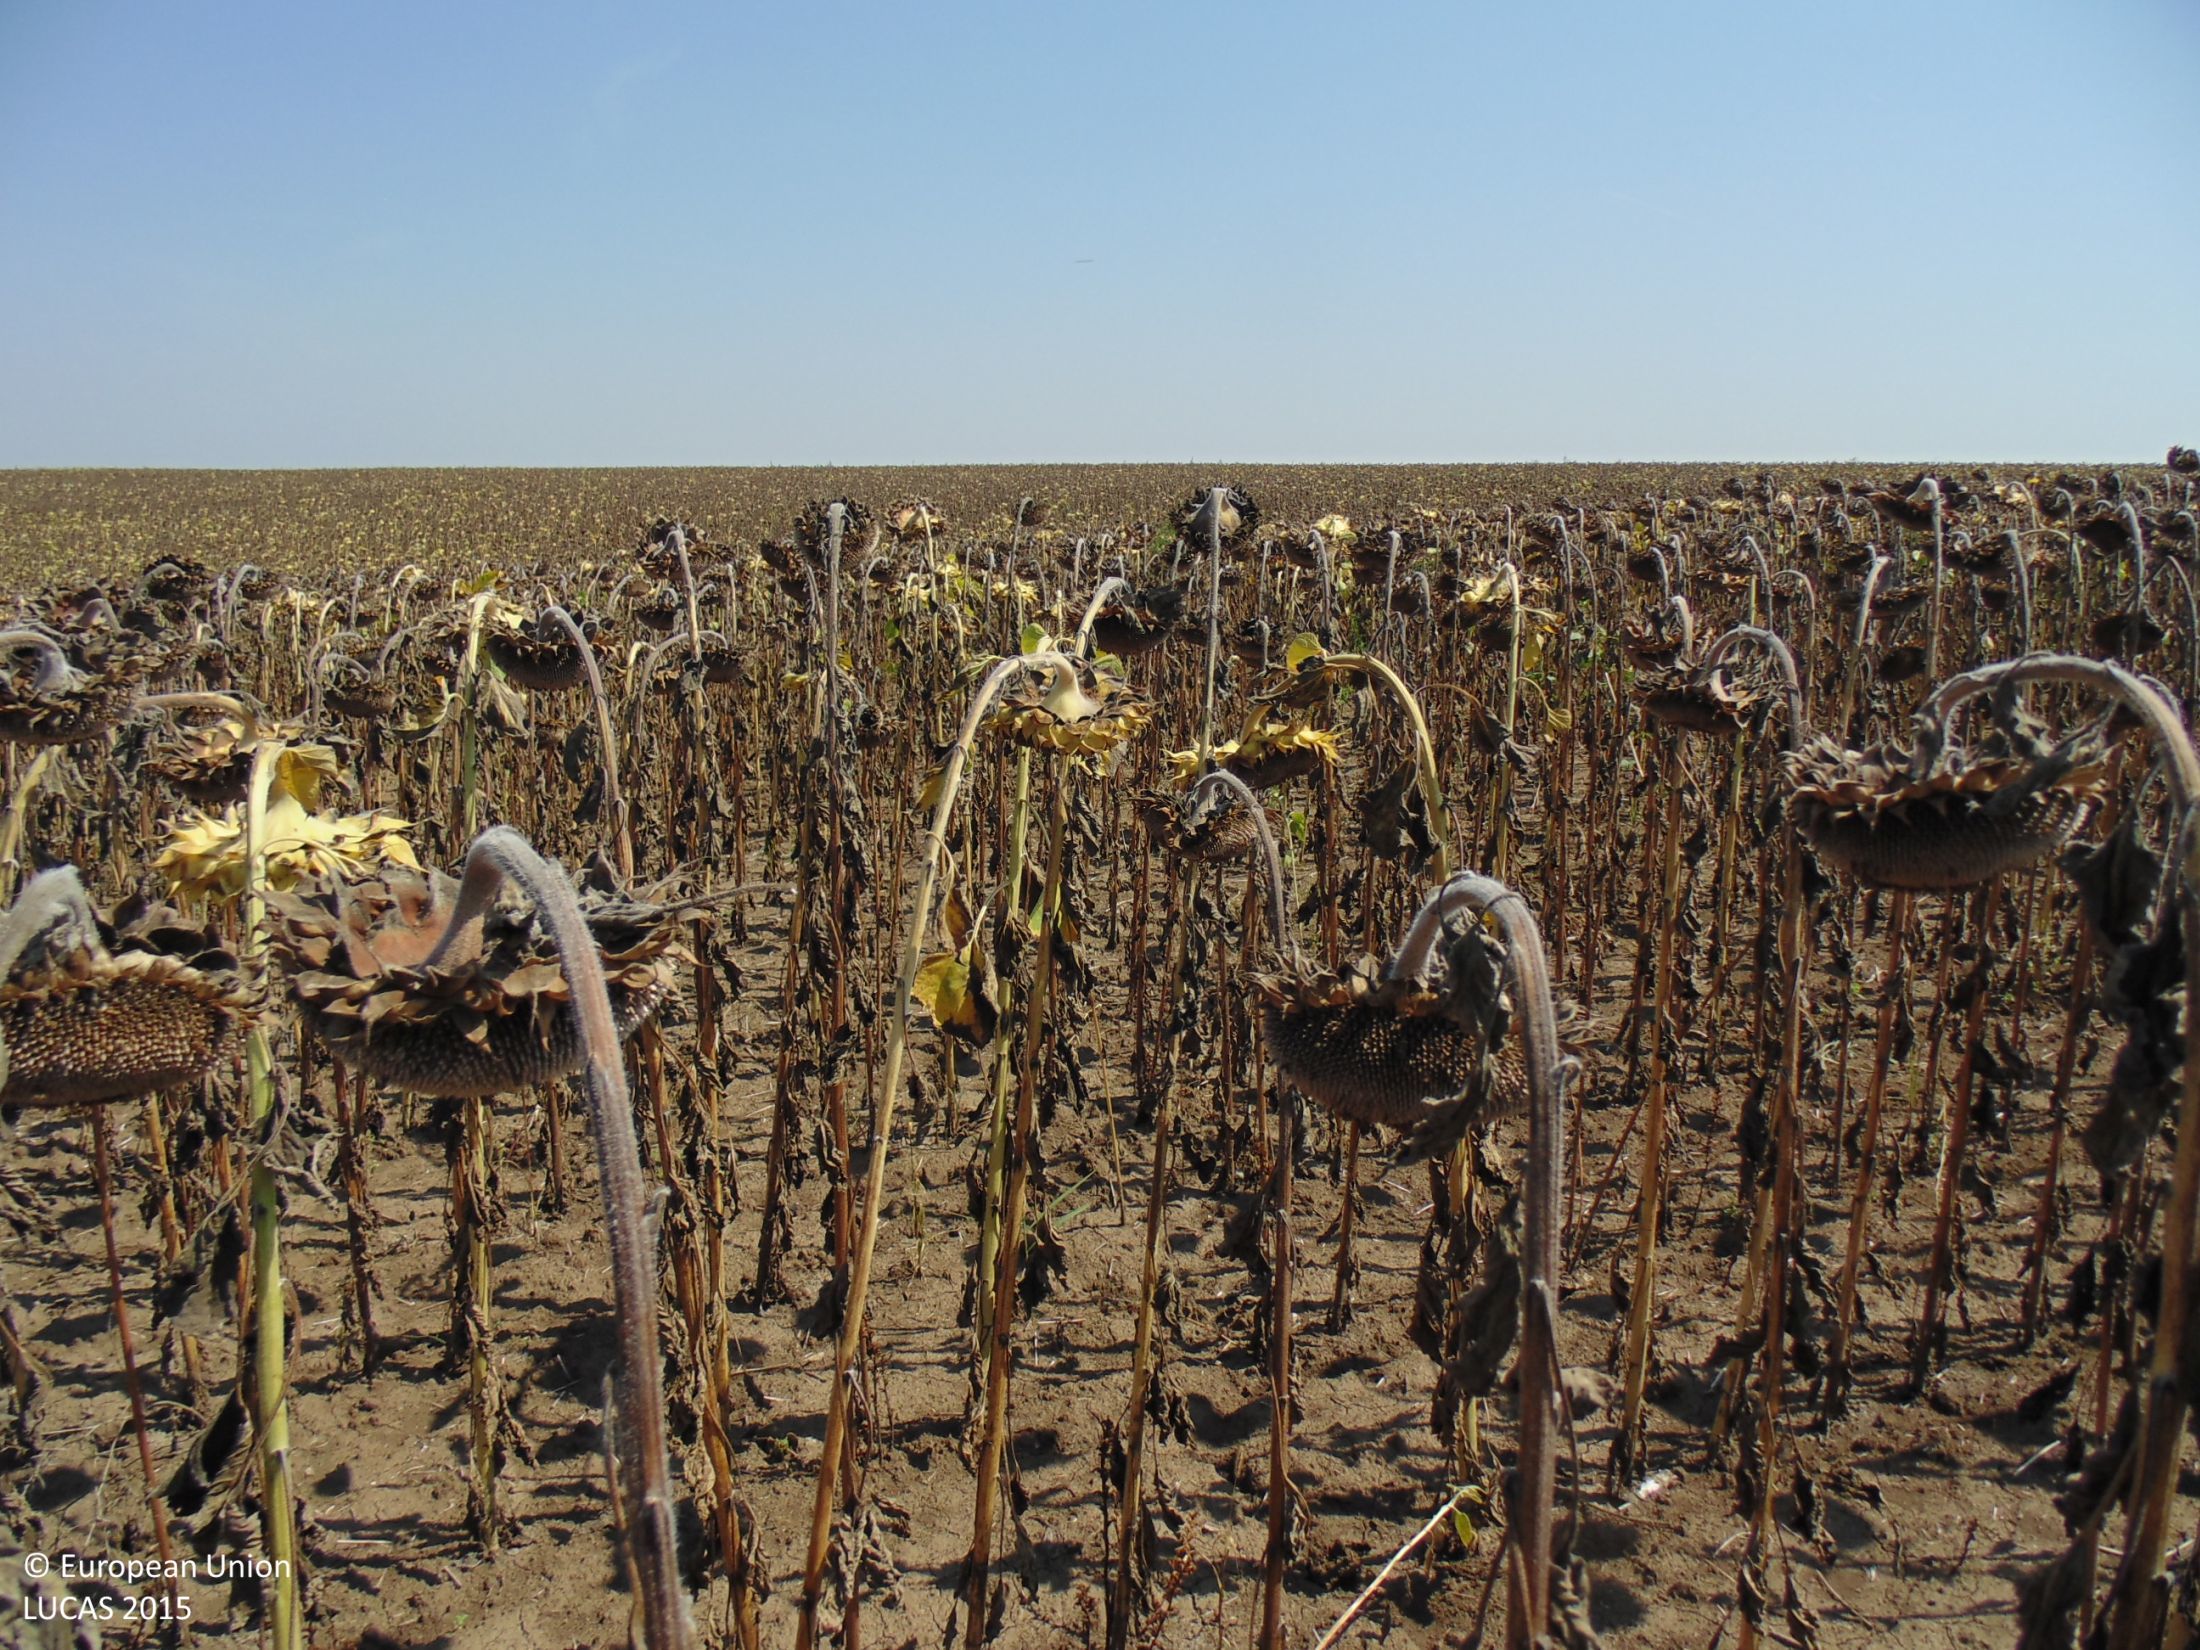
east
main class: Cropland
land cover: Sunflower
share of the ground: > 75 %
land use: Agriculture (excluding fallow land and kitchen gardens)
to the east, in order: Sunflower
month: August
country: BG
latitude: 43.7239
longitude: 27.4491
